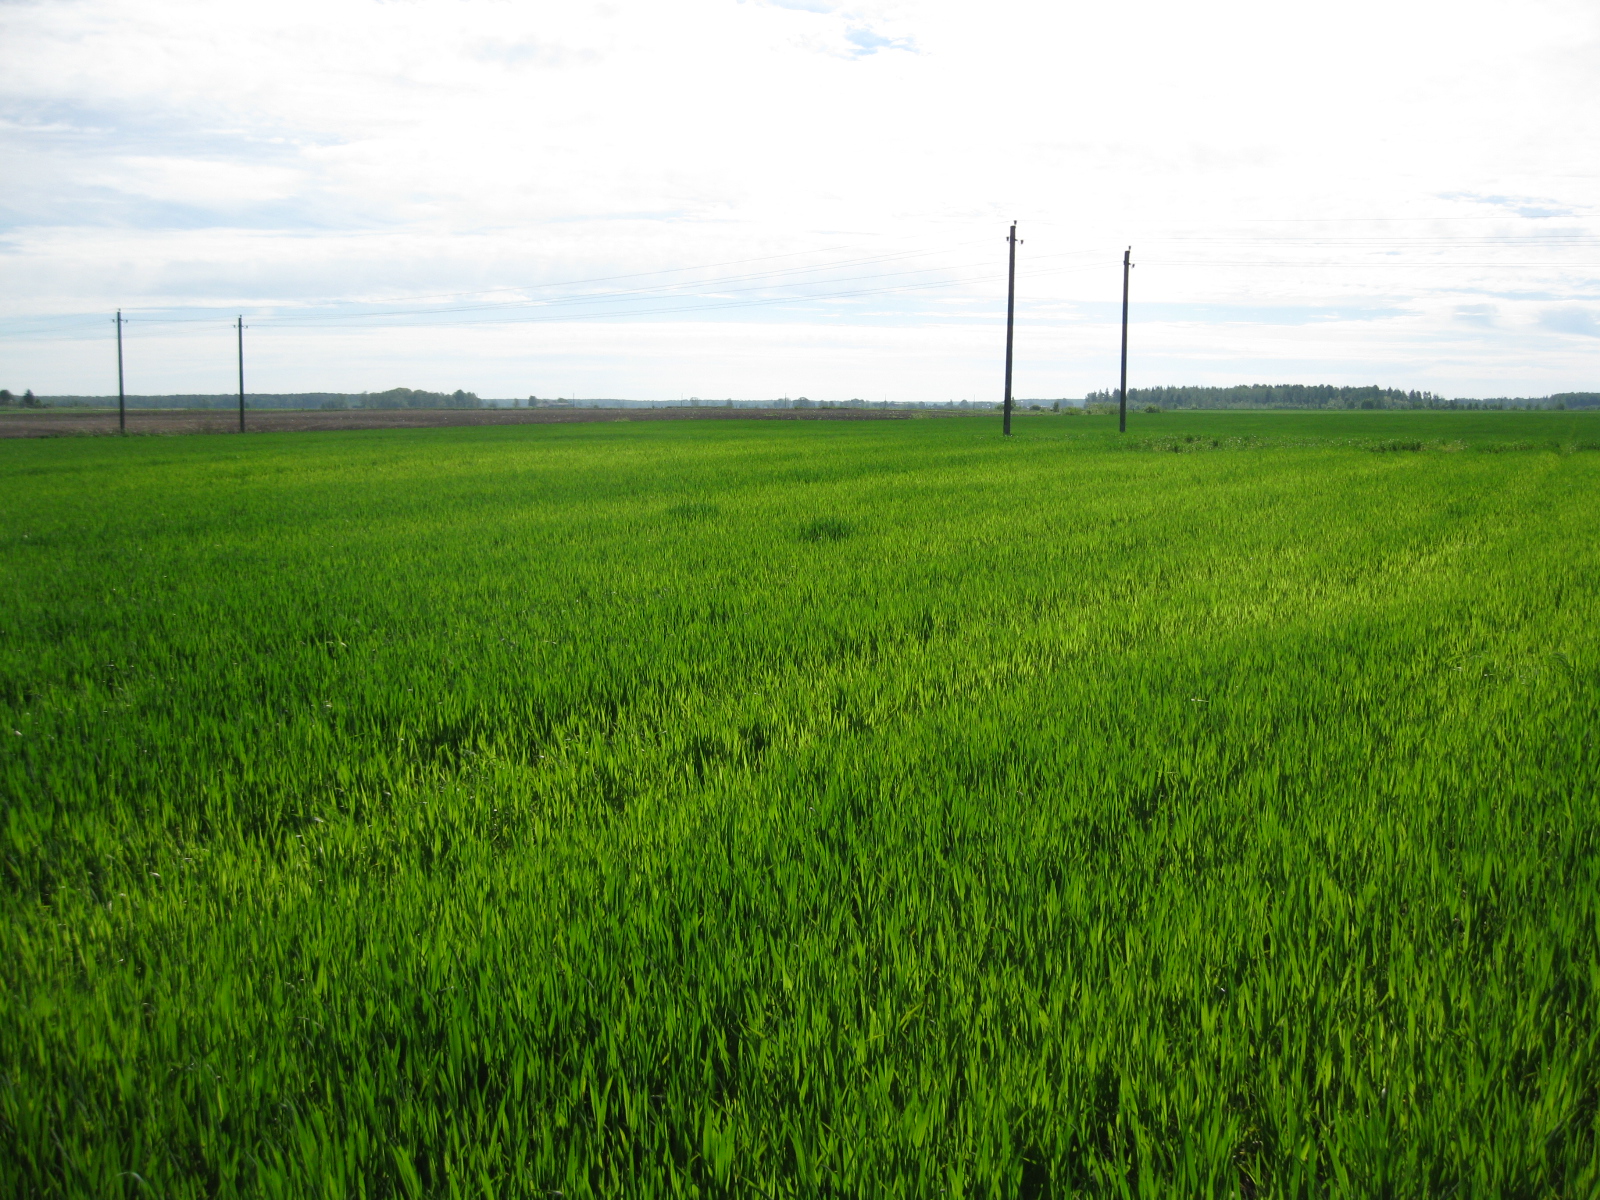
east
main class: Cropland
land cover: Common wheat
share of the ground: > 75 %
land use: Agriculture (excluding fallow land and kitchen gardens)
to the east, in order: Common wheat; Electric lines; Common wheat; Electric lines; Common wheat; Spontaneously vegetated surfaces; Ditches and canals; Grass margins; Other bare soil
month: May
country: LT
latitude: 55.8359
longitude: 24.3215
